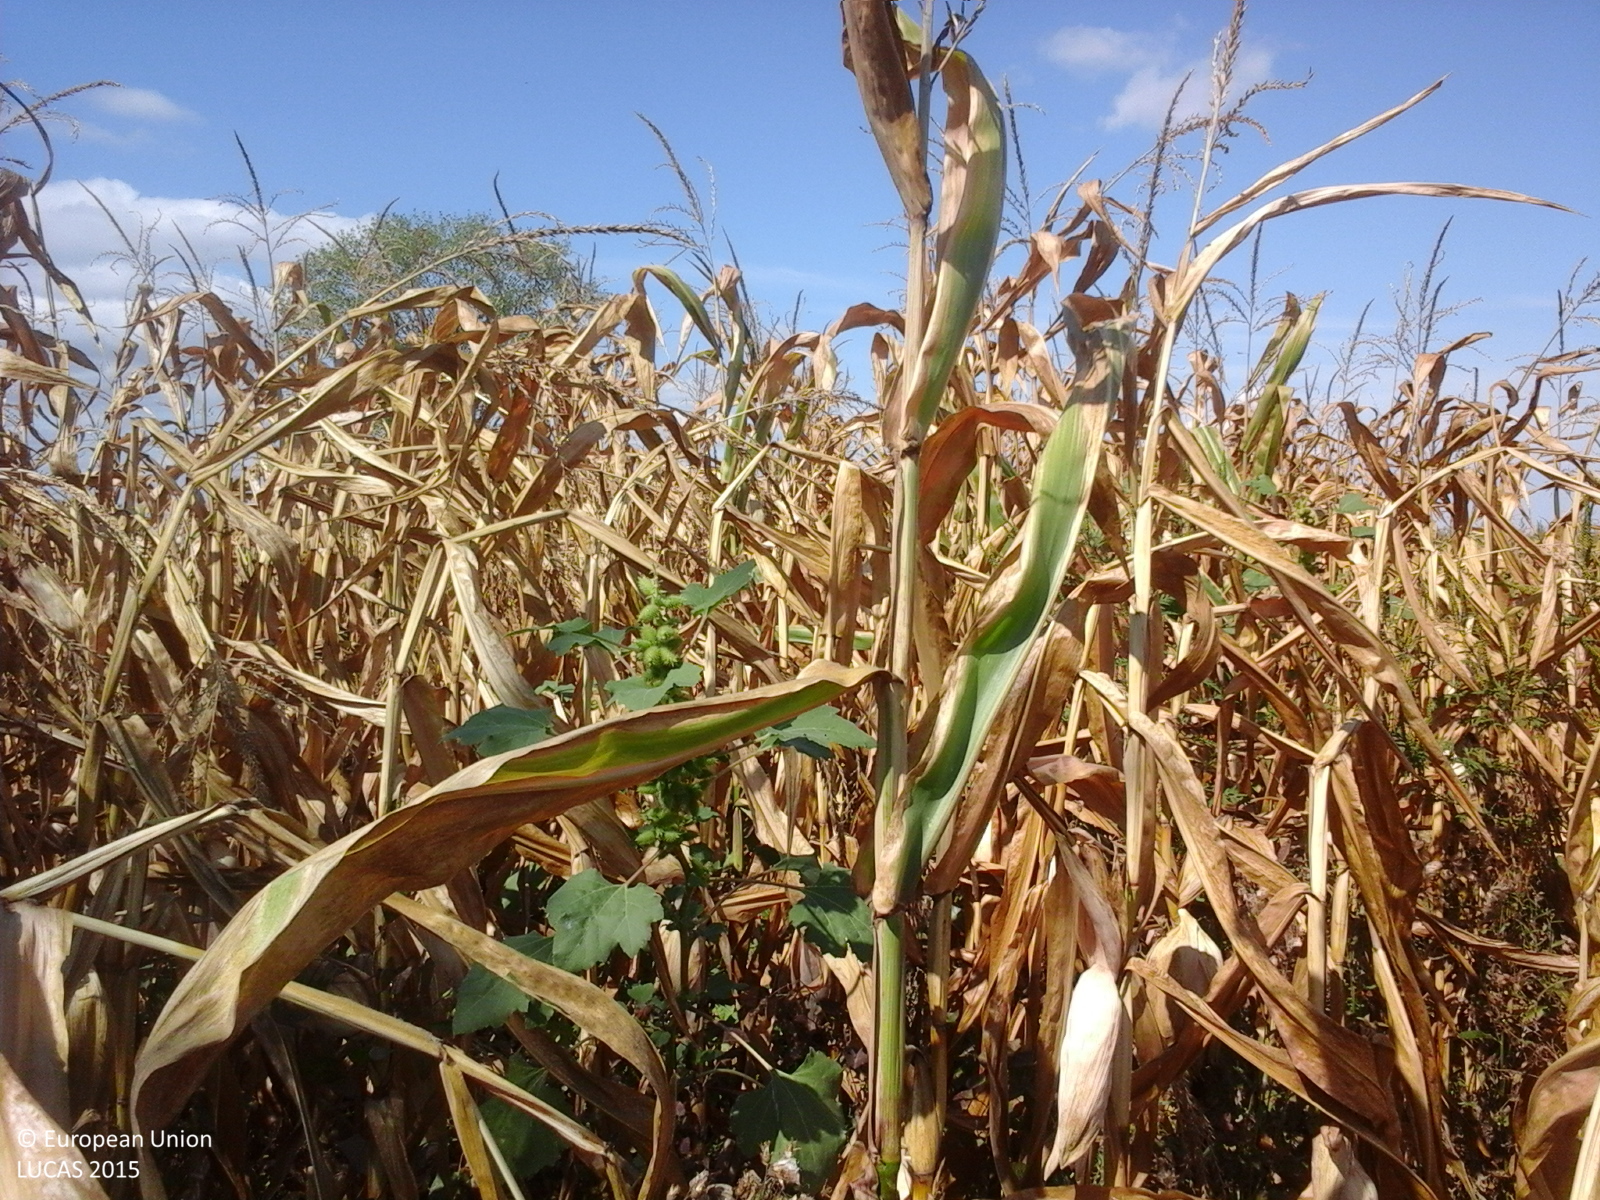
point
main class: Cropland
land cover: Maize
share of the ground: > 75 %
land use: Agriculture (excluding fallow land and kitchen gardens)
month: September
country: RO
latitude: 47.7989
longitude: 22.9766
